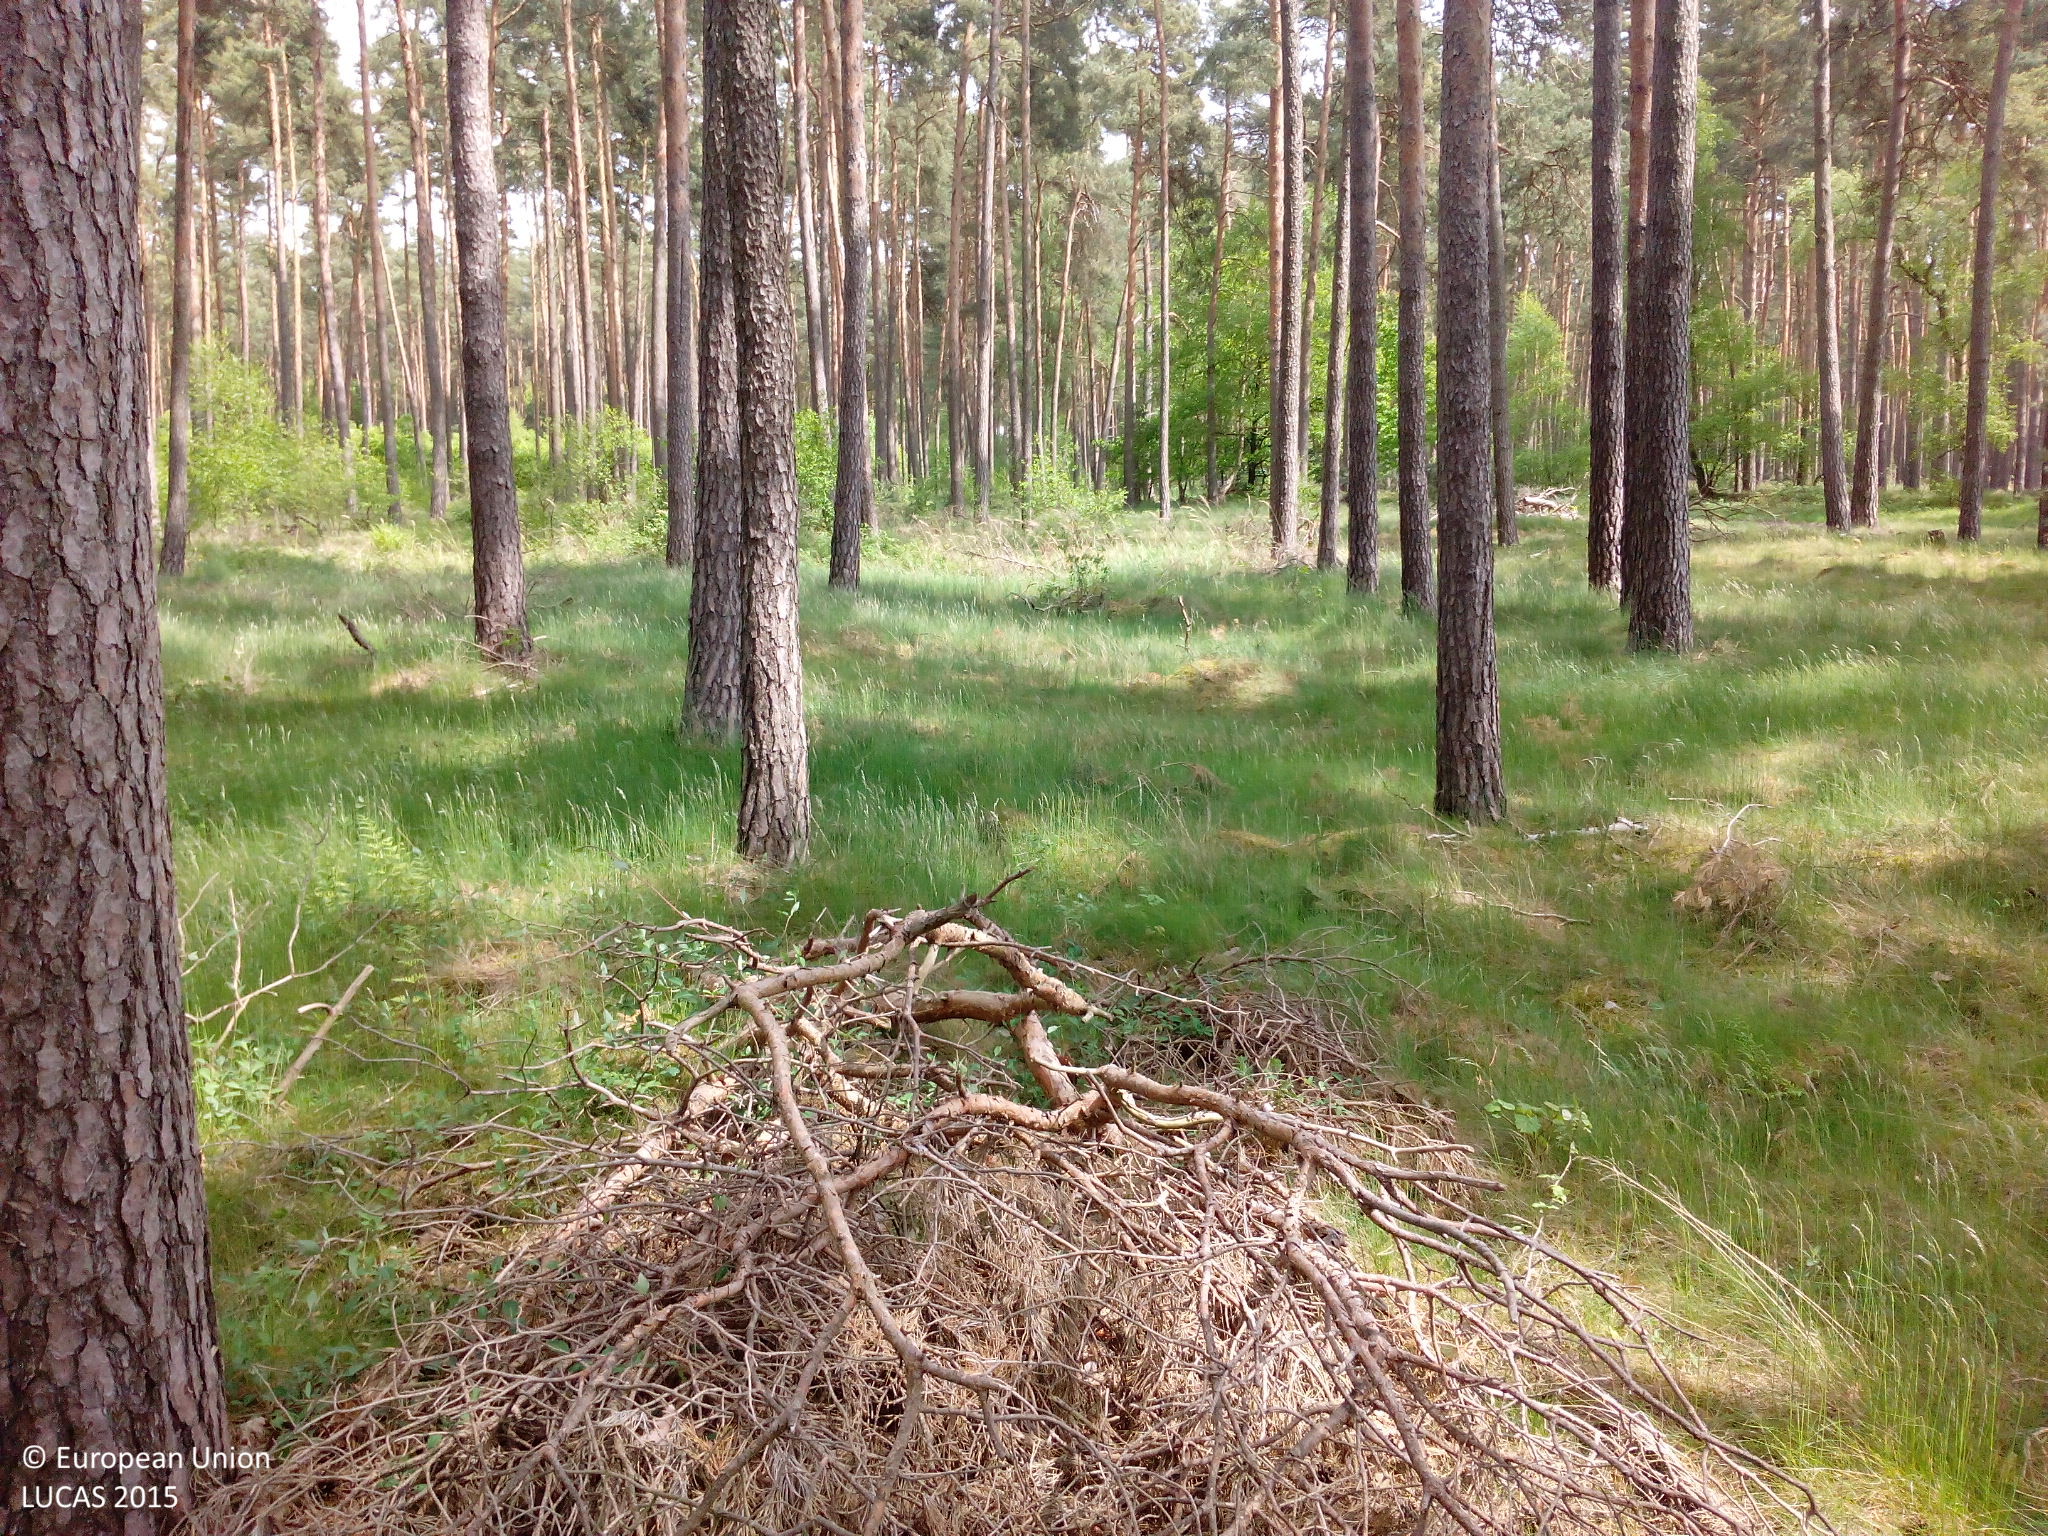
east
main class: Woodland
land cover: Pine dominated coniferous woodland
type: hemiboreal forest and nemoral coniferous forest and mixed broadleaved-coniferous forest
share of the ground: 50 - 75 %
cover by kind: coniferous forest trees 60 %, herbaceous plants 30 %, shrubs 10 %
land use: Forestry
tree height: > 5 m
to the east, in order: Pine dominated coniferous woodland; Broadleaved woodland; Tracks; Pine dominated coniferous woodland
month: May
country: DE
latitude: 52.6596
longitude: 11.1380
